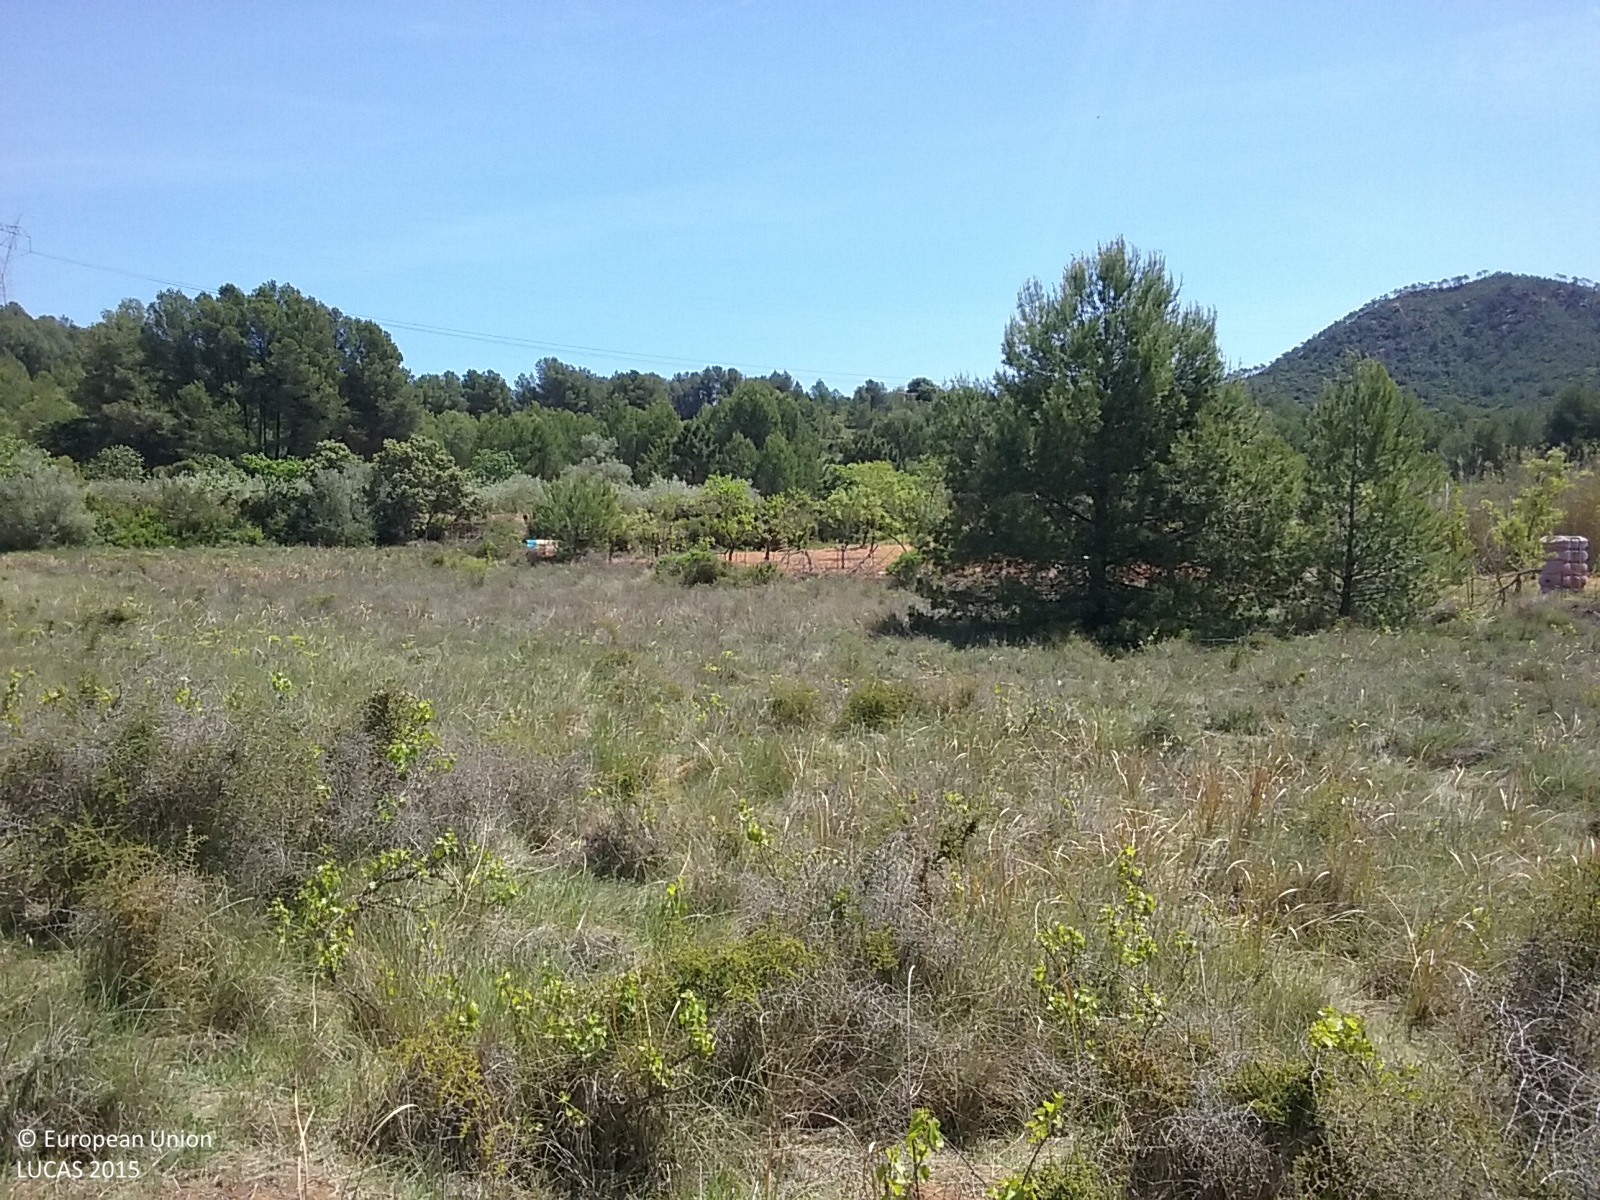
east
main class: Shrubland
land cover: Shrubland with sparse tree cover
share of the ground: > 75 %
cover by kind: herbaceous plants 75 %, shrubs 20 %, broadleaved forest trees 5 %
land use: Abandoned areas
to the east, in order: Shrubland with sparse tree cover; Fences; Nuts trees; Abandoned hedges; Fences; Olive groves; Shrubland with sparse tree cover; Dry stone walls; Pine dominated coniferous woodland; Dry stone walls; Pine dominated coniferous woodland; Dry stone walls; Pine dominated coniferous woodland; Tracks; Nuts trees; Dry stone walls; Nuts trees; Dry stone walls; Nuts trees
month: May
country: ES
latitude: 40.1208
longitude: 0.0123
